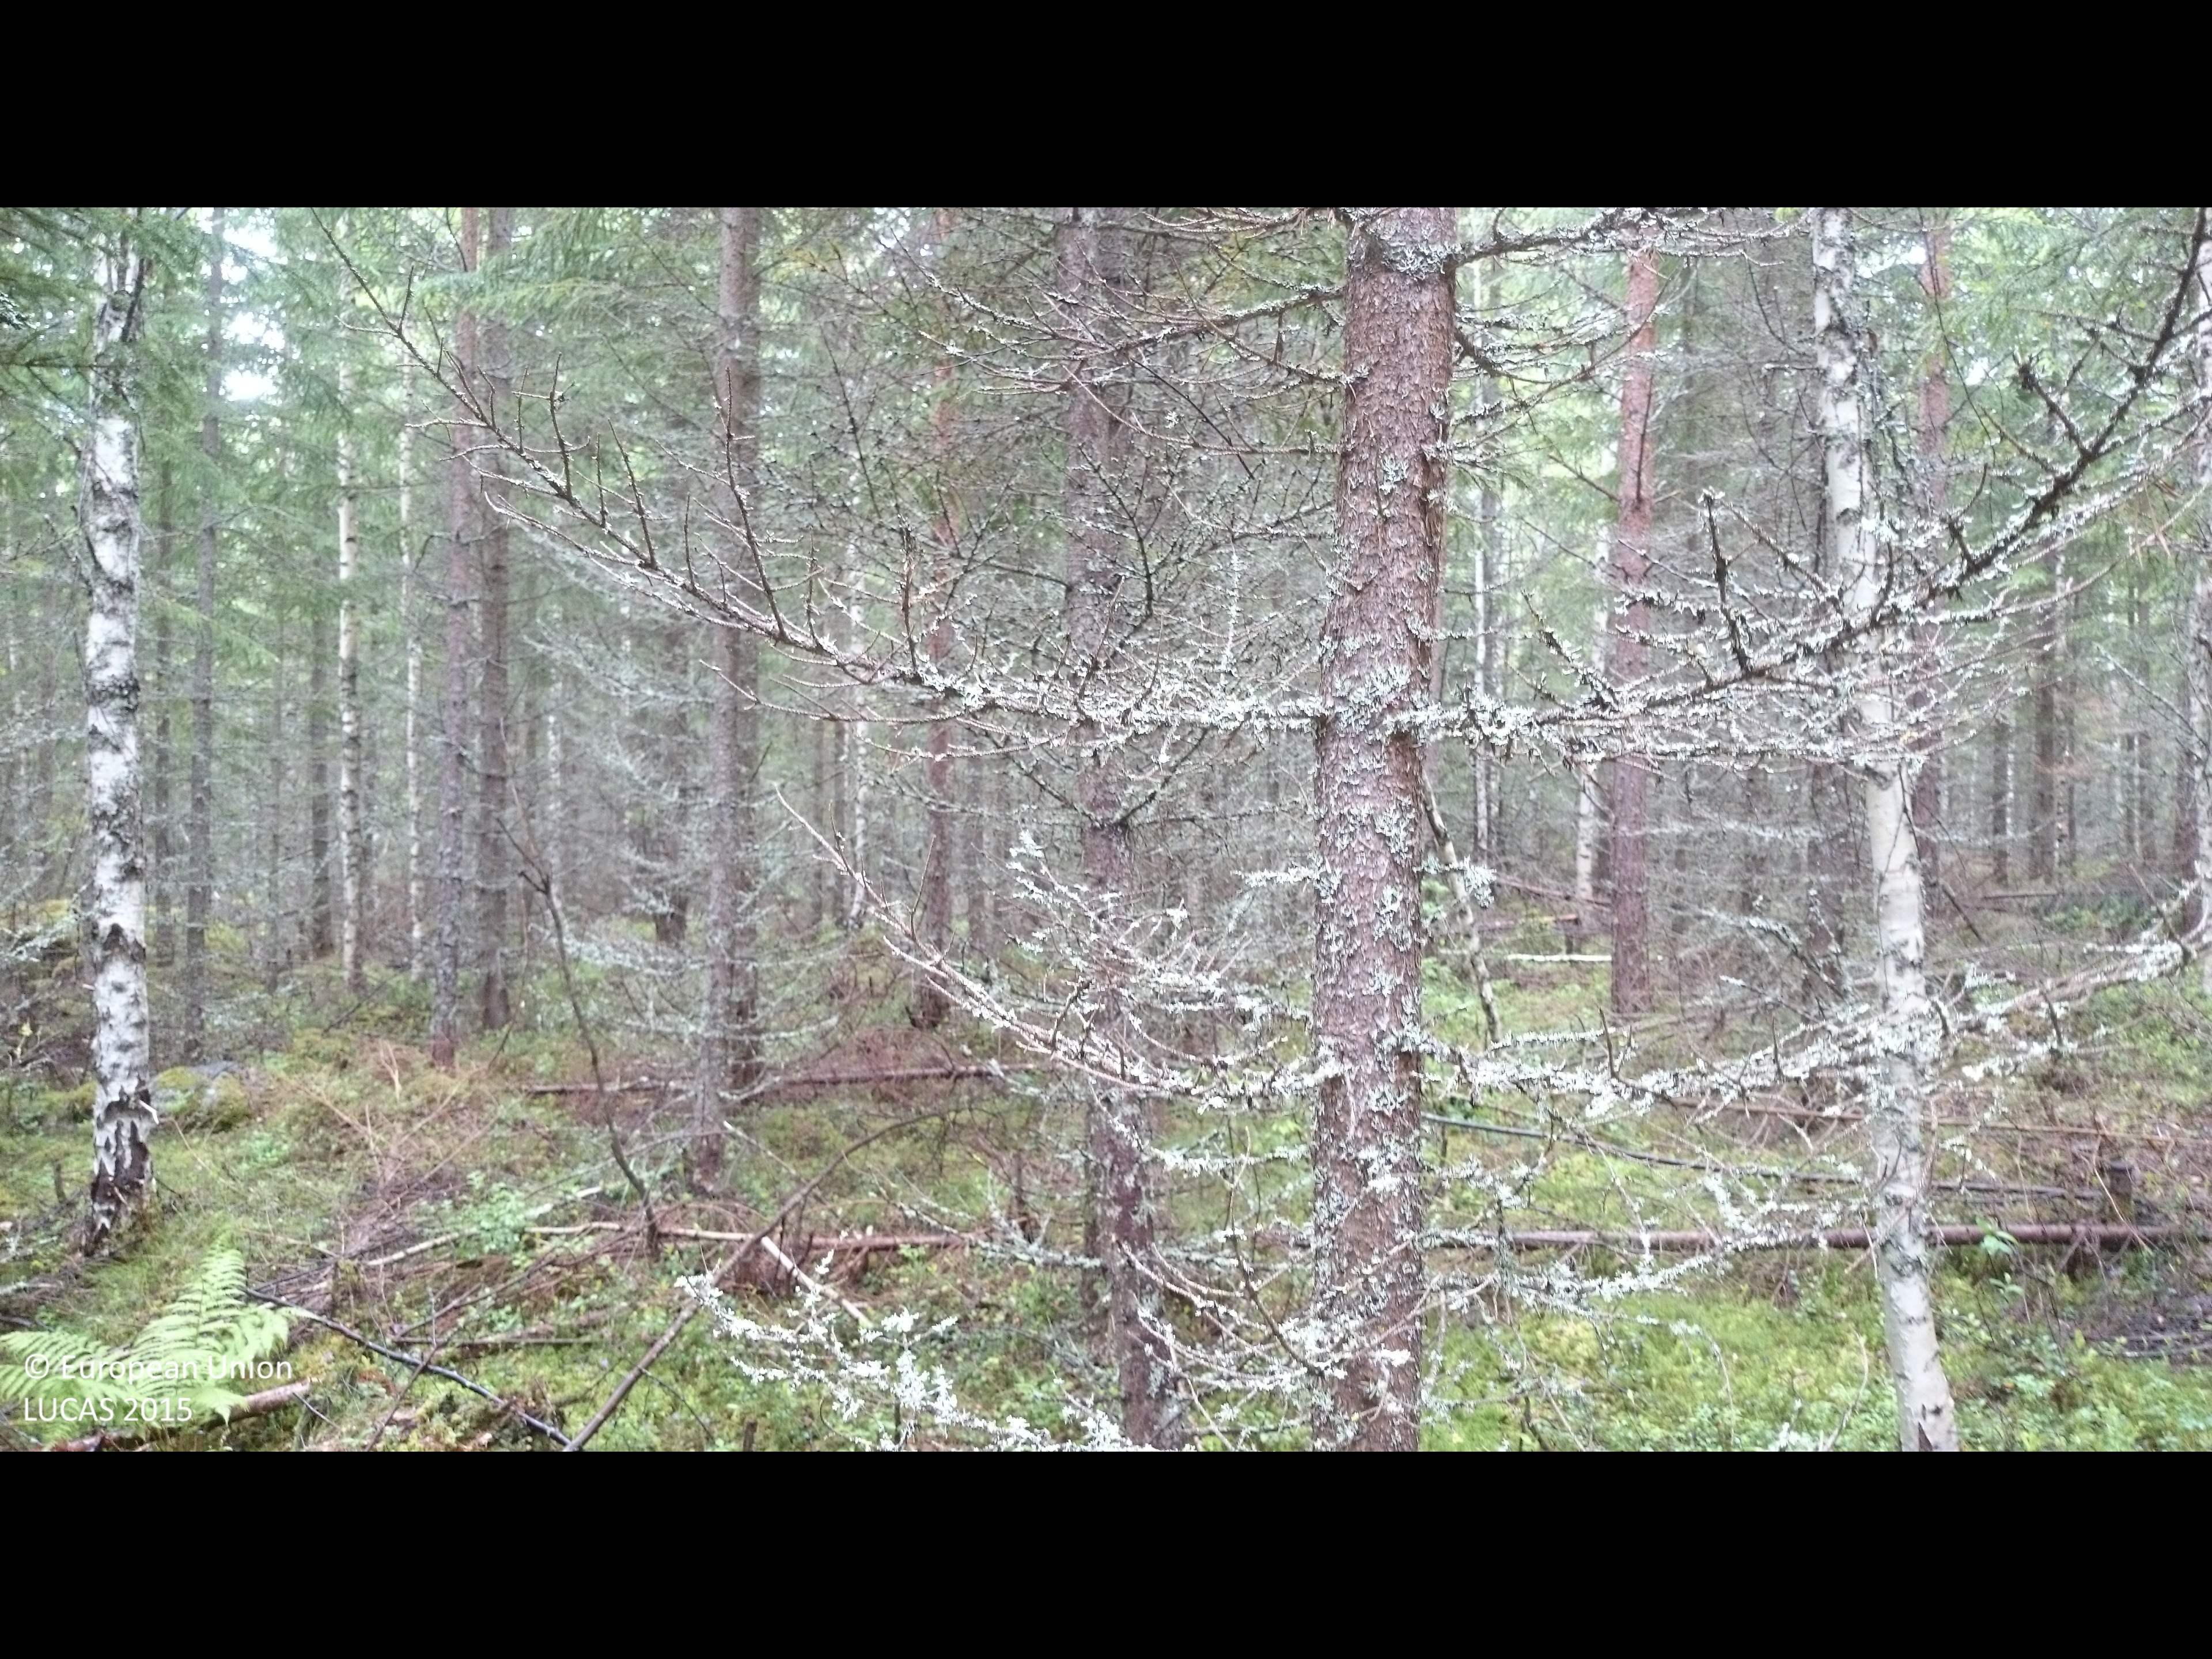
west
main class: Woodland
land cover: Spruce dominated mixed woodland
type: boreal forest
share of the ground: 25 - 50 %
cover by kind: lichens and mosses 35 %, coniferous forest trees 30 %, shrubs 20 %, broadleaved forest trees 15 %
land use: Forestry
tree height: > 5 m
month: June
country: SE
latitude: 61.9883
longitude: 16.7959
